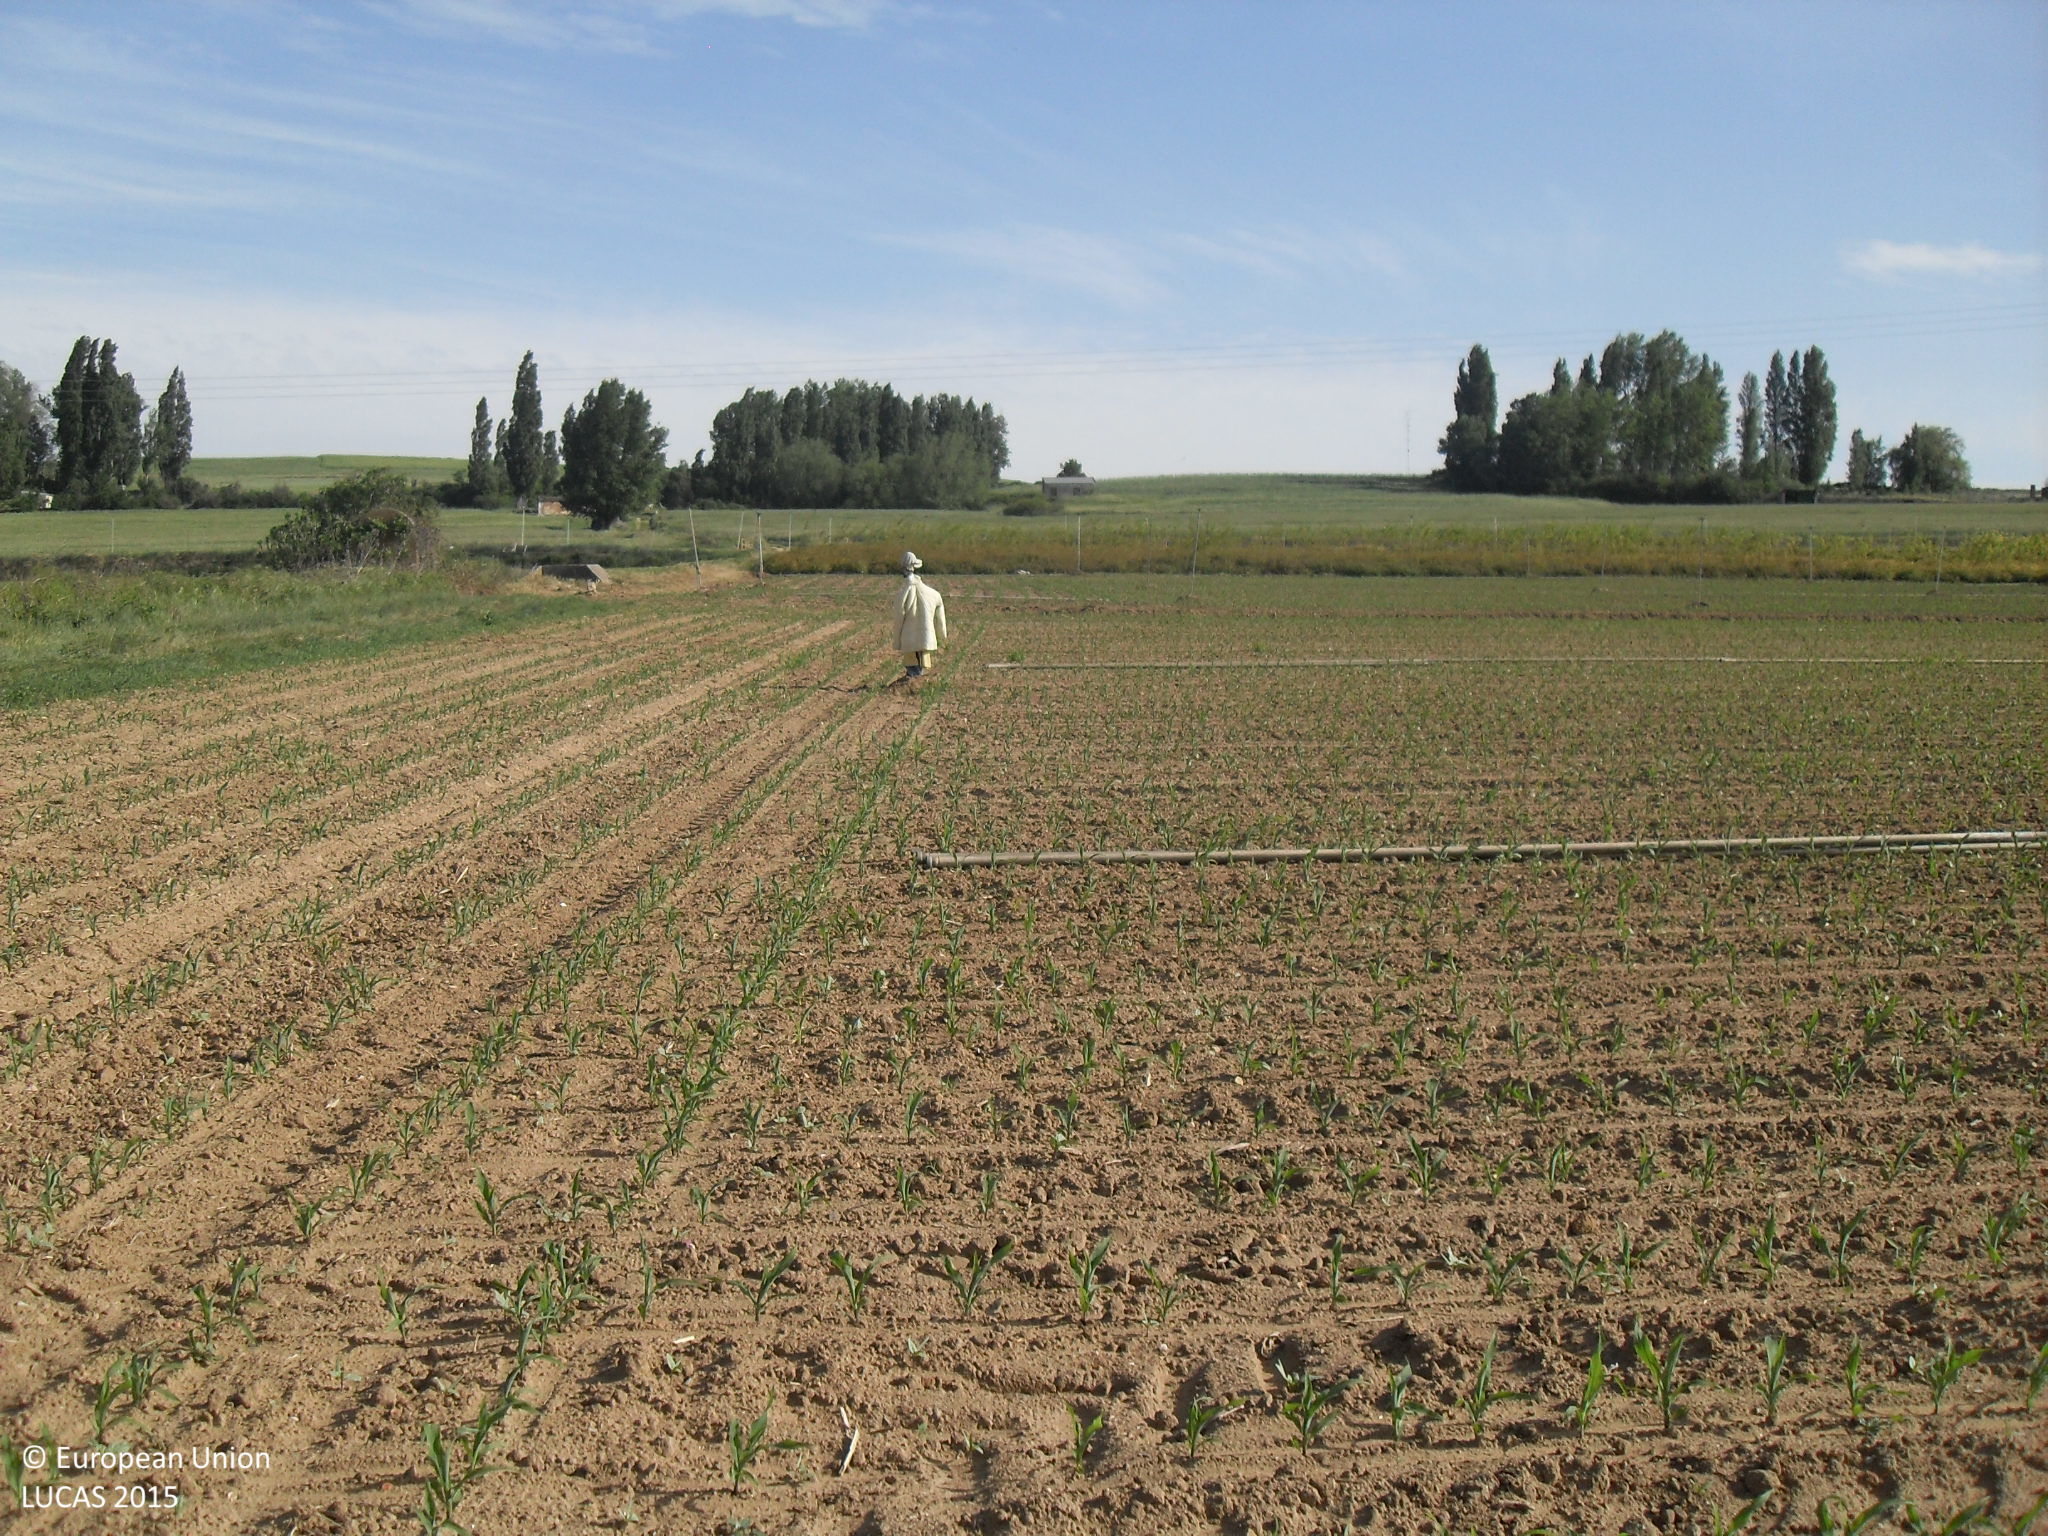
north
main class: Cropland
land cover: Maize
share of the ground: > 75 %
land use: Agriculture (excluding fallow land and kitchen gardens)
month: May
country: ES
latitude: 41.0093
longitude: -5.3992
